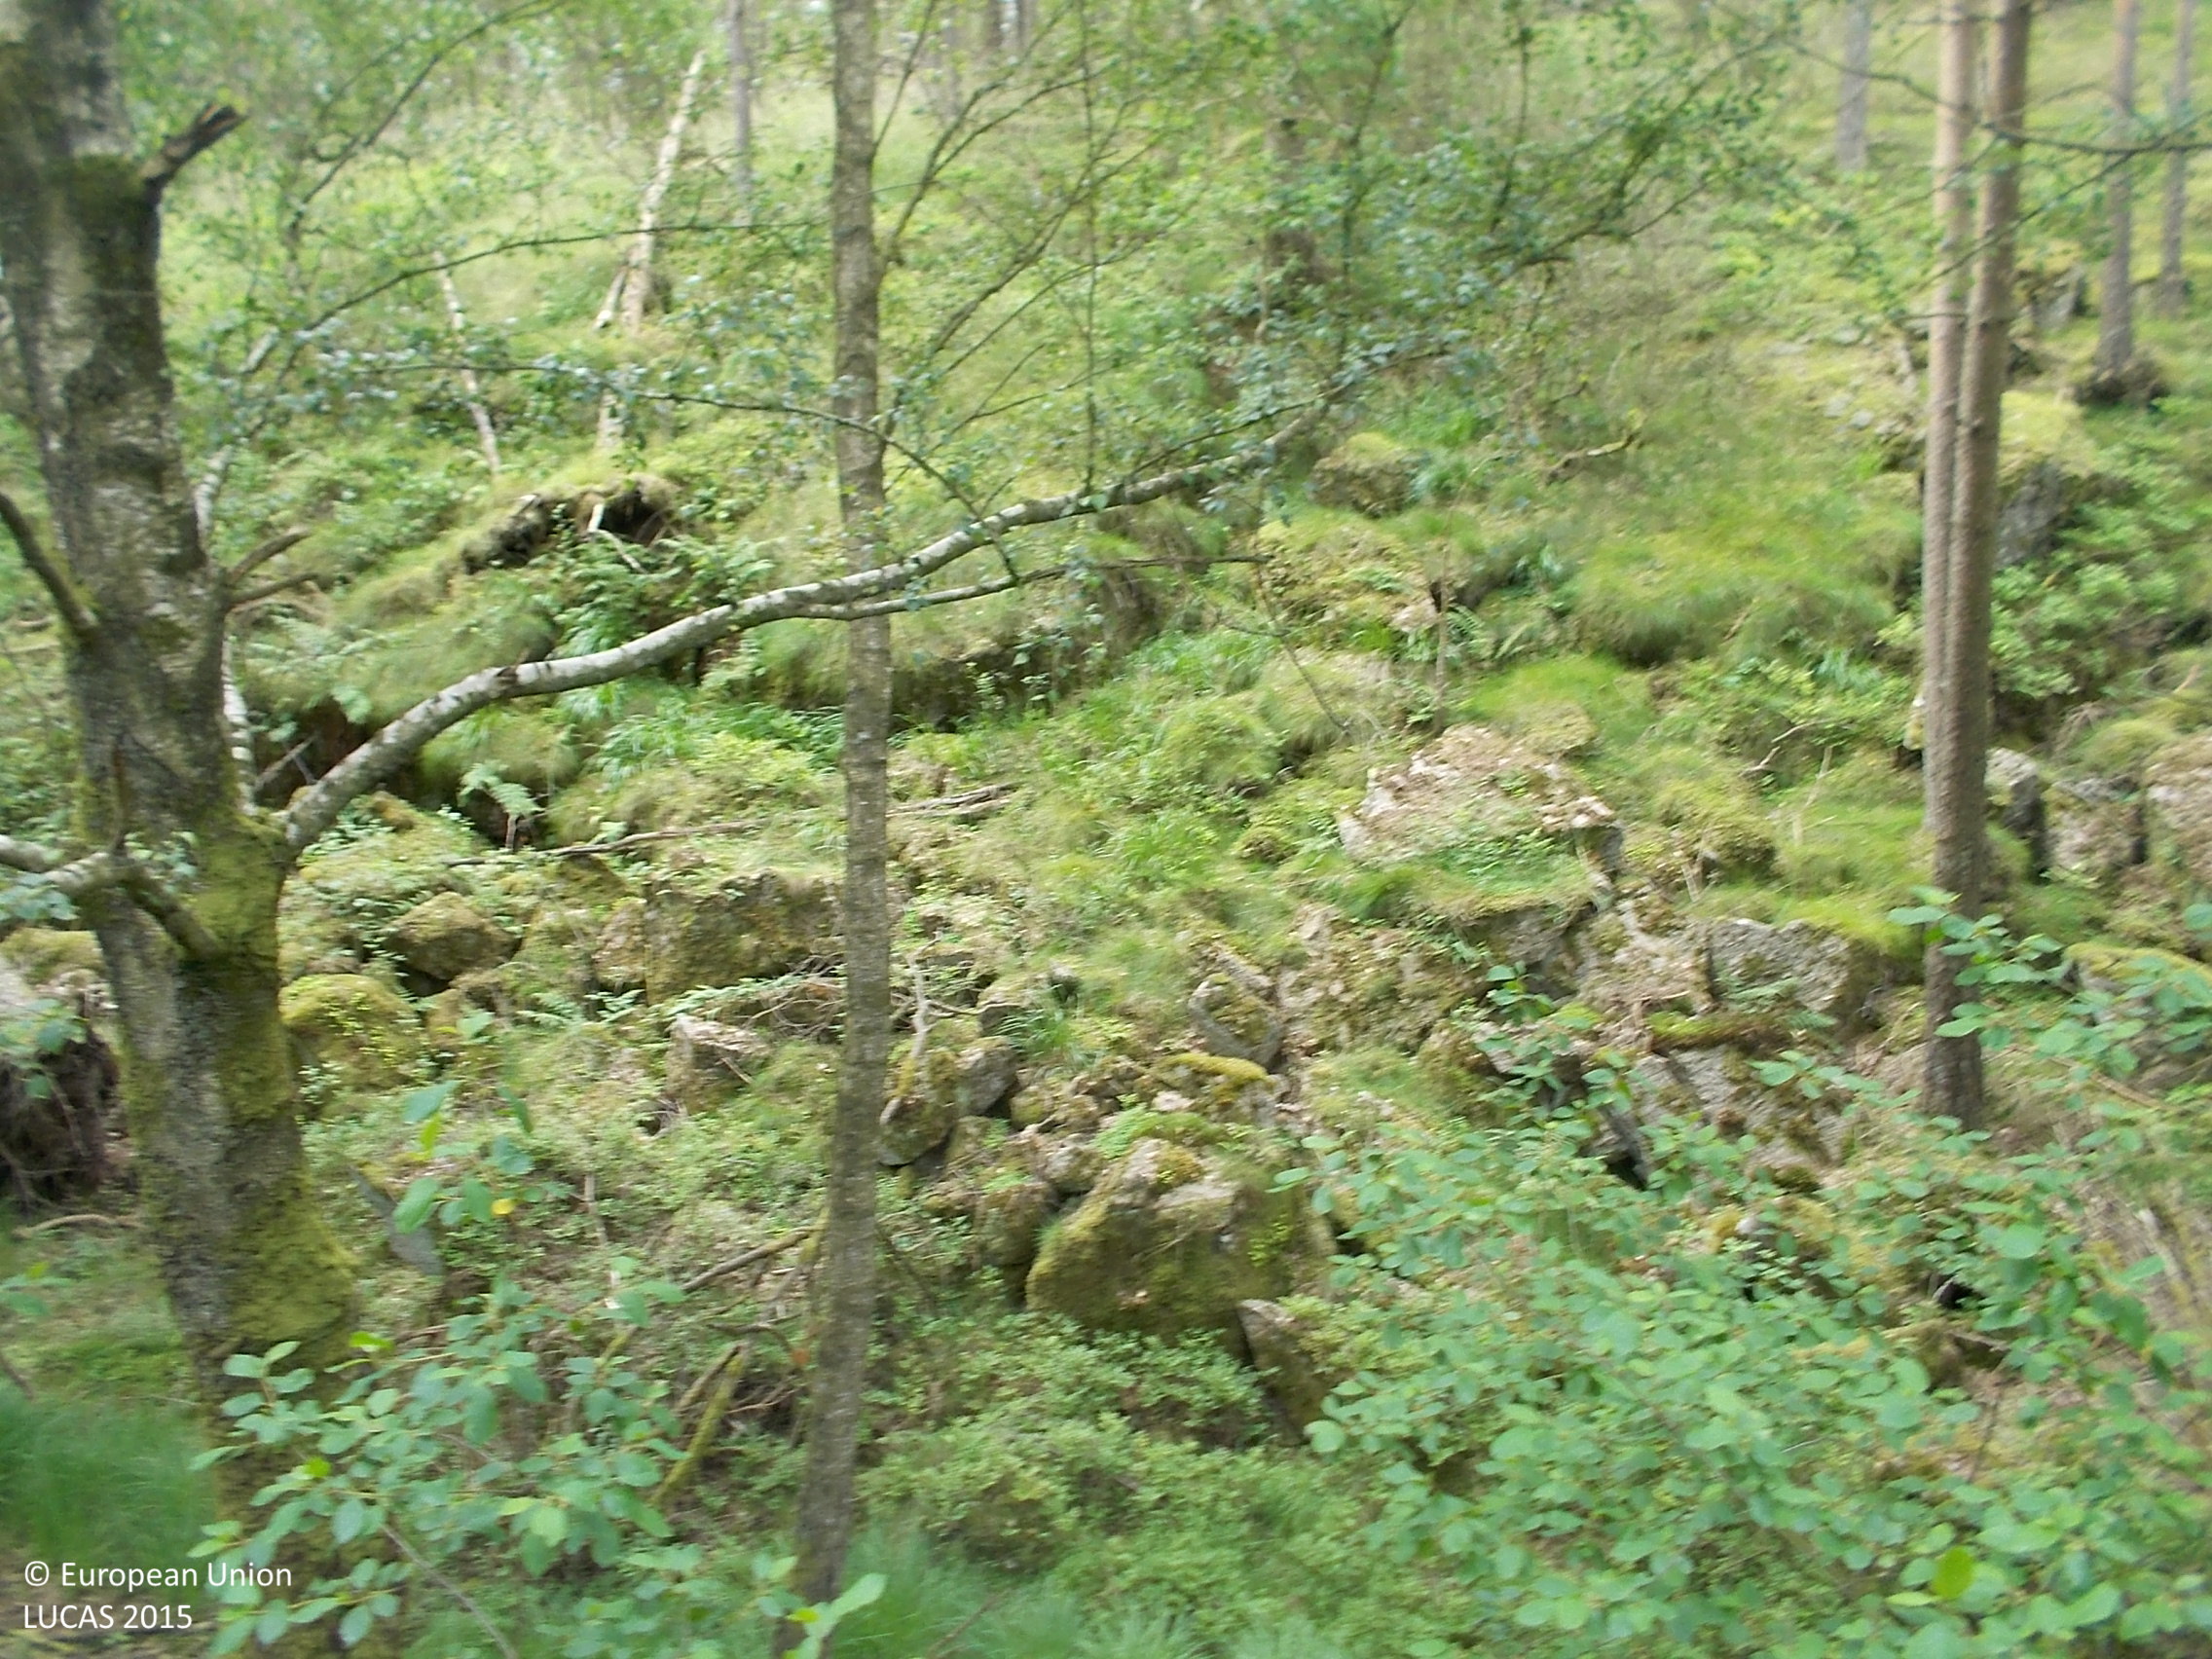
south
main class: Woodland
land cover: Broadleaved woodland
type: hemiboreal forest and nemoral coniferous forest and mixed broadleaved-coniferous forest
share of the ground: > 75 %
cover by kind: broadleaved forest trees 80 %, herbaceous plants 10 %, shrubs 5 %, lichens and mosses 5 %
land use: Forestry
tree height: > 5 m
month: July
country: SE
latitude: 57.2834
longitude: 12.2363
